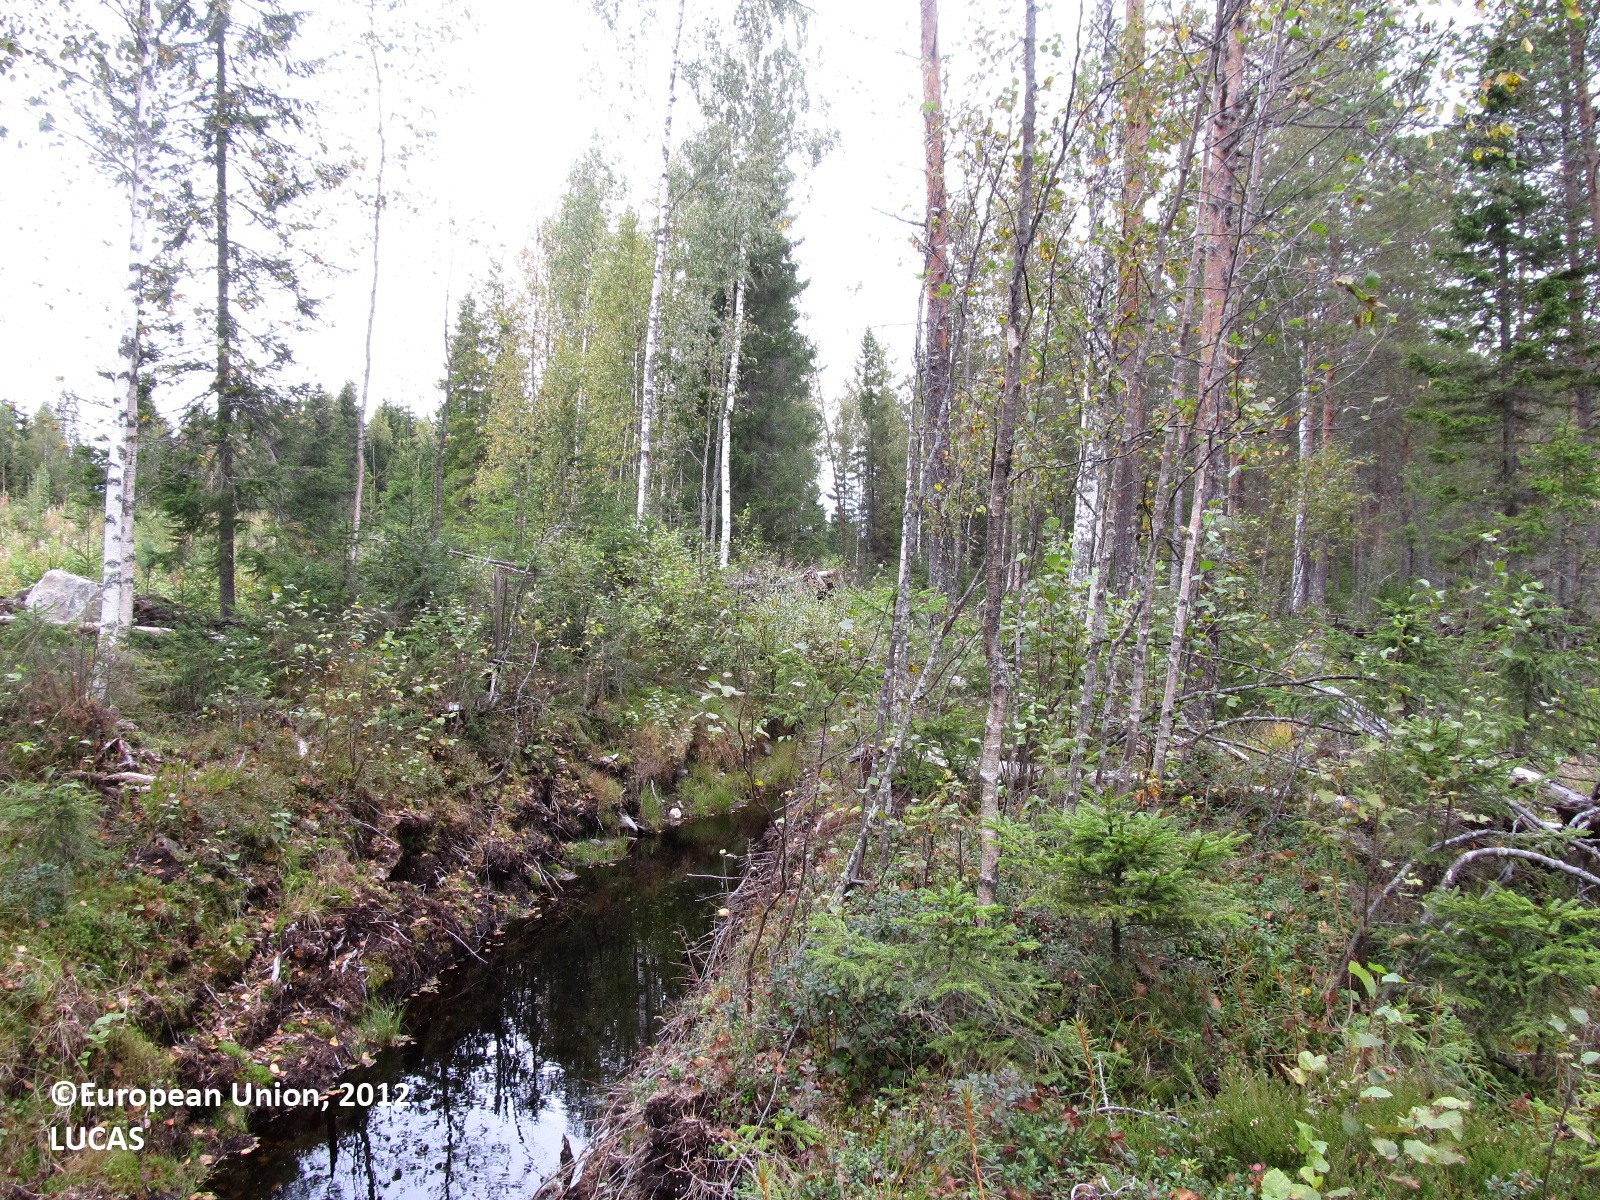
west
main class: Woodland
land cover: Pine dominated coniferous woodland
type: boreal forest
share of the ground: 25 - 50 %
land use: Forestry
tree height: > 5 m
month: September
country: FI
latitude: 63.0653
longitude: 28.5394
